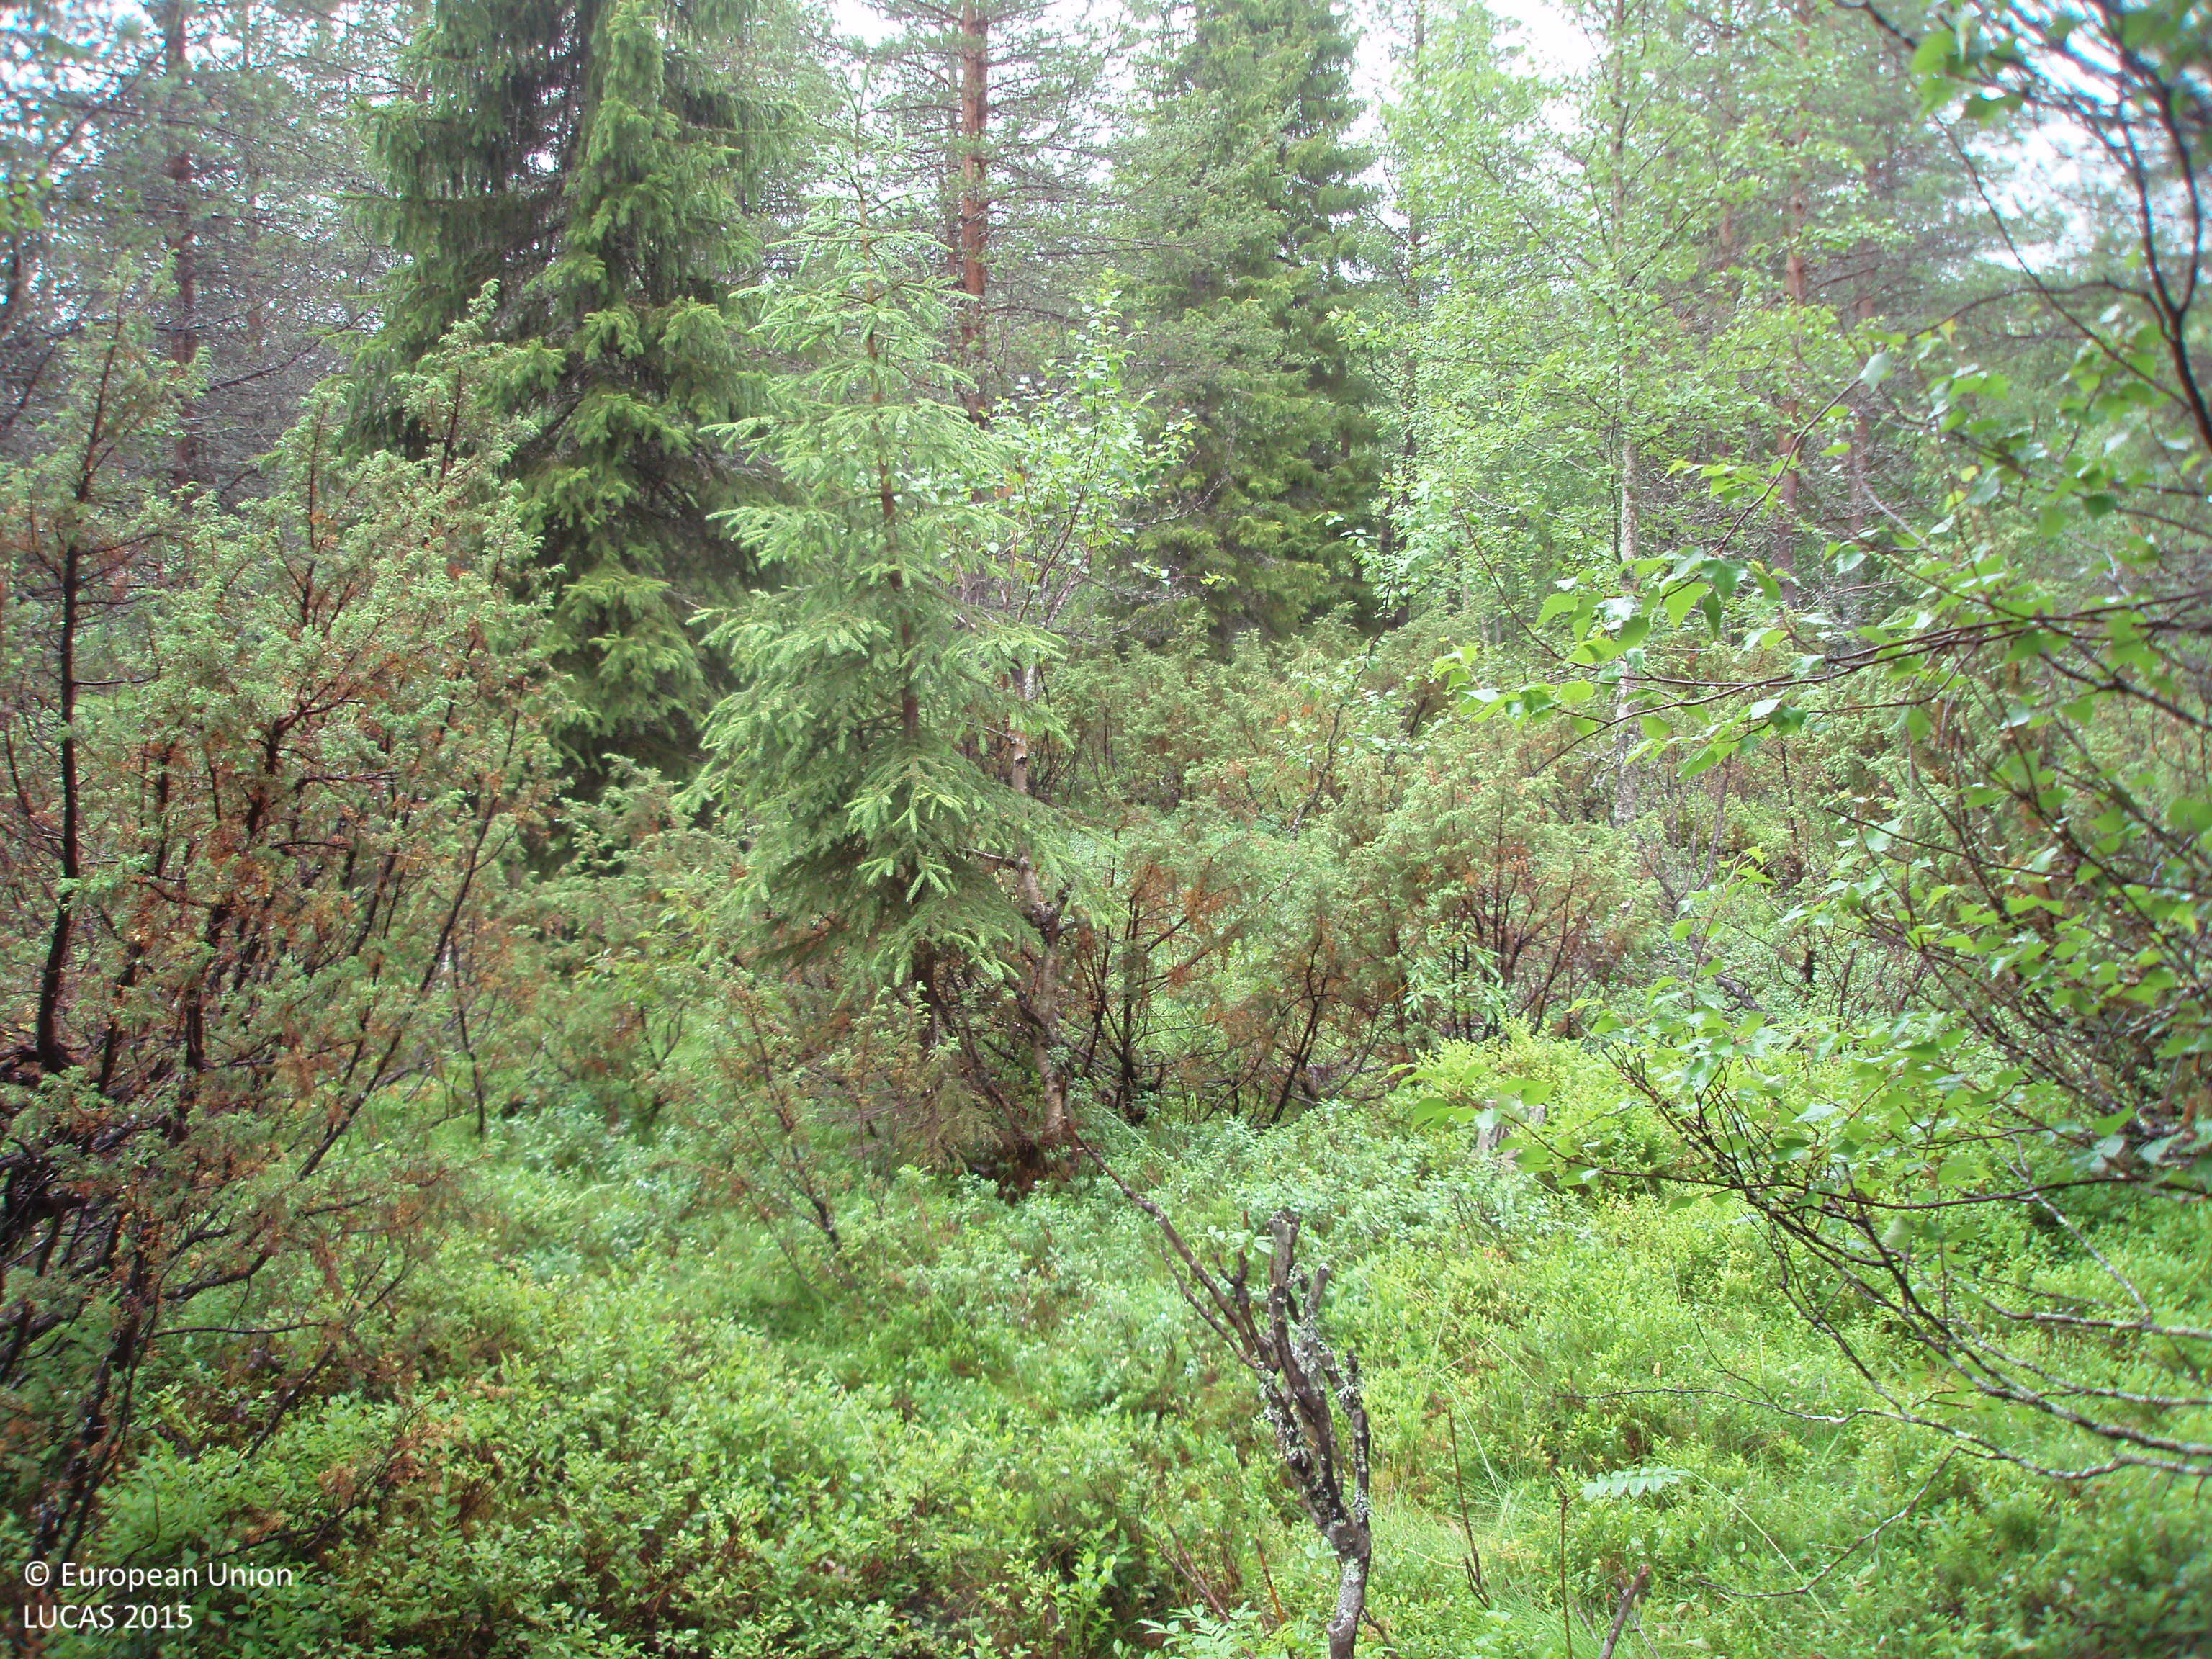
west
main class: Woodland
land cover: Pine dominated mixed woodland
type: boreal forest
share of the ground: > 75 %
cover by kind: coniferous forest trees 55 %, broadleaved forest trees 25 %, shrubs 20 %
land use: Forestry
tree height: > 5 m
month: August
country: FI
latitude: 65.6316
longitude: 27.4816
